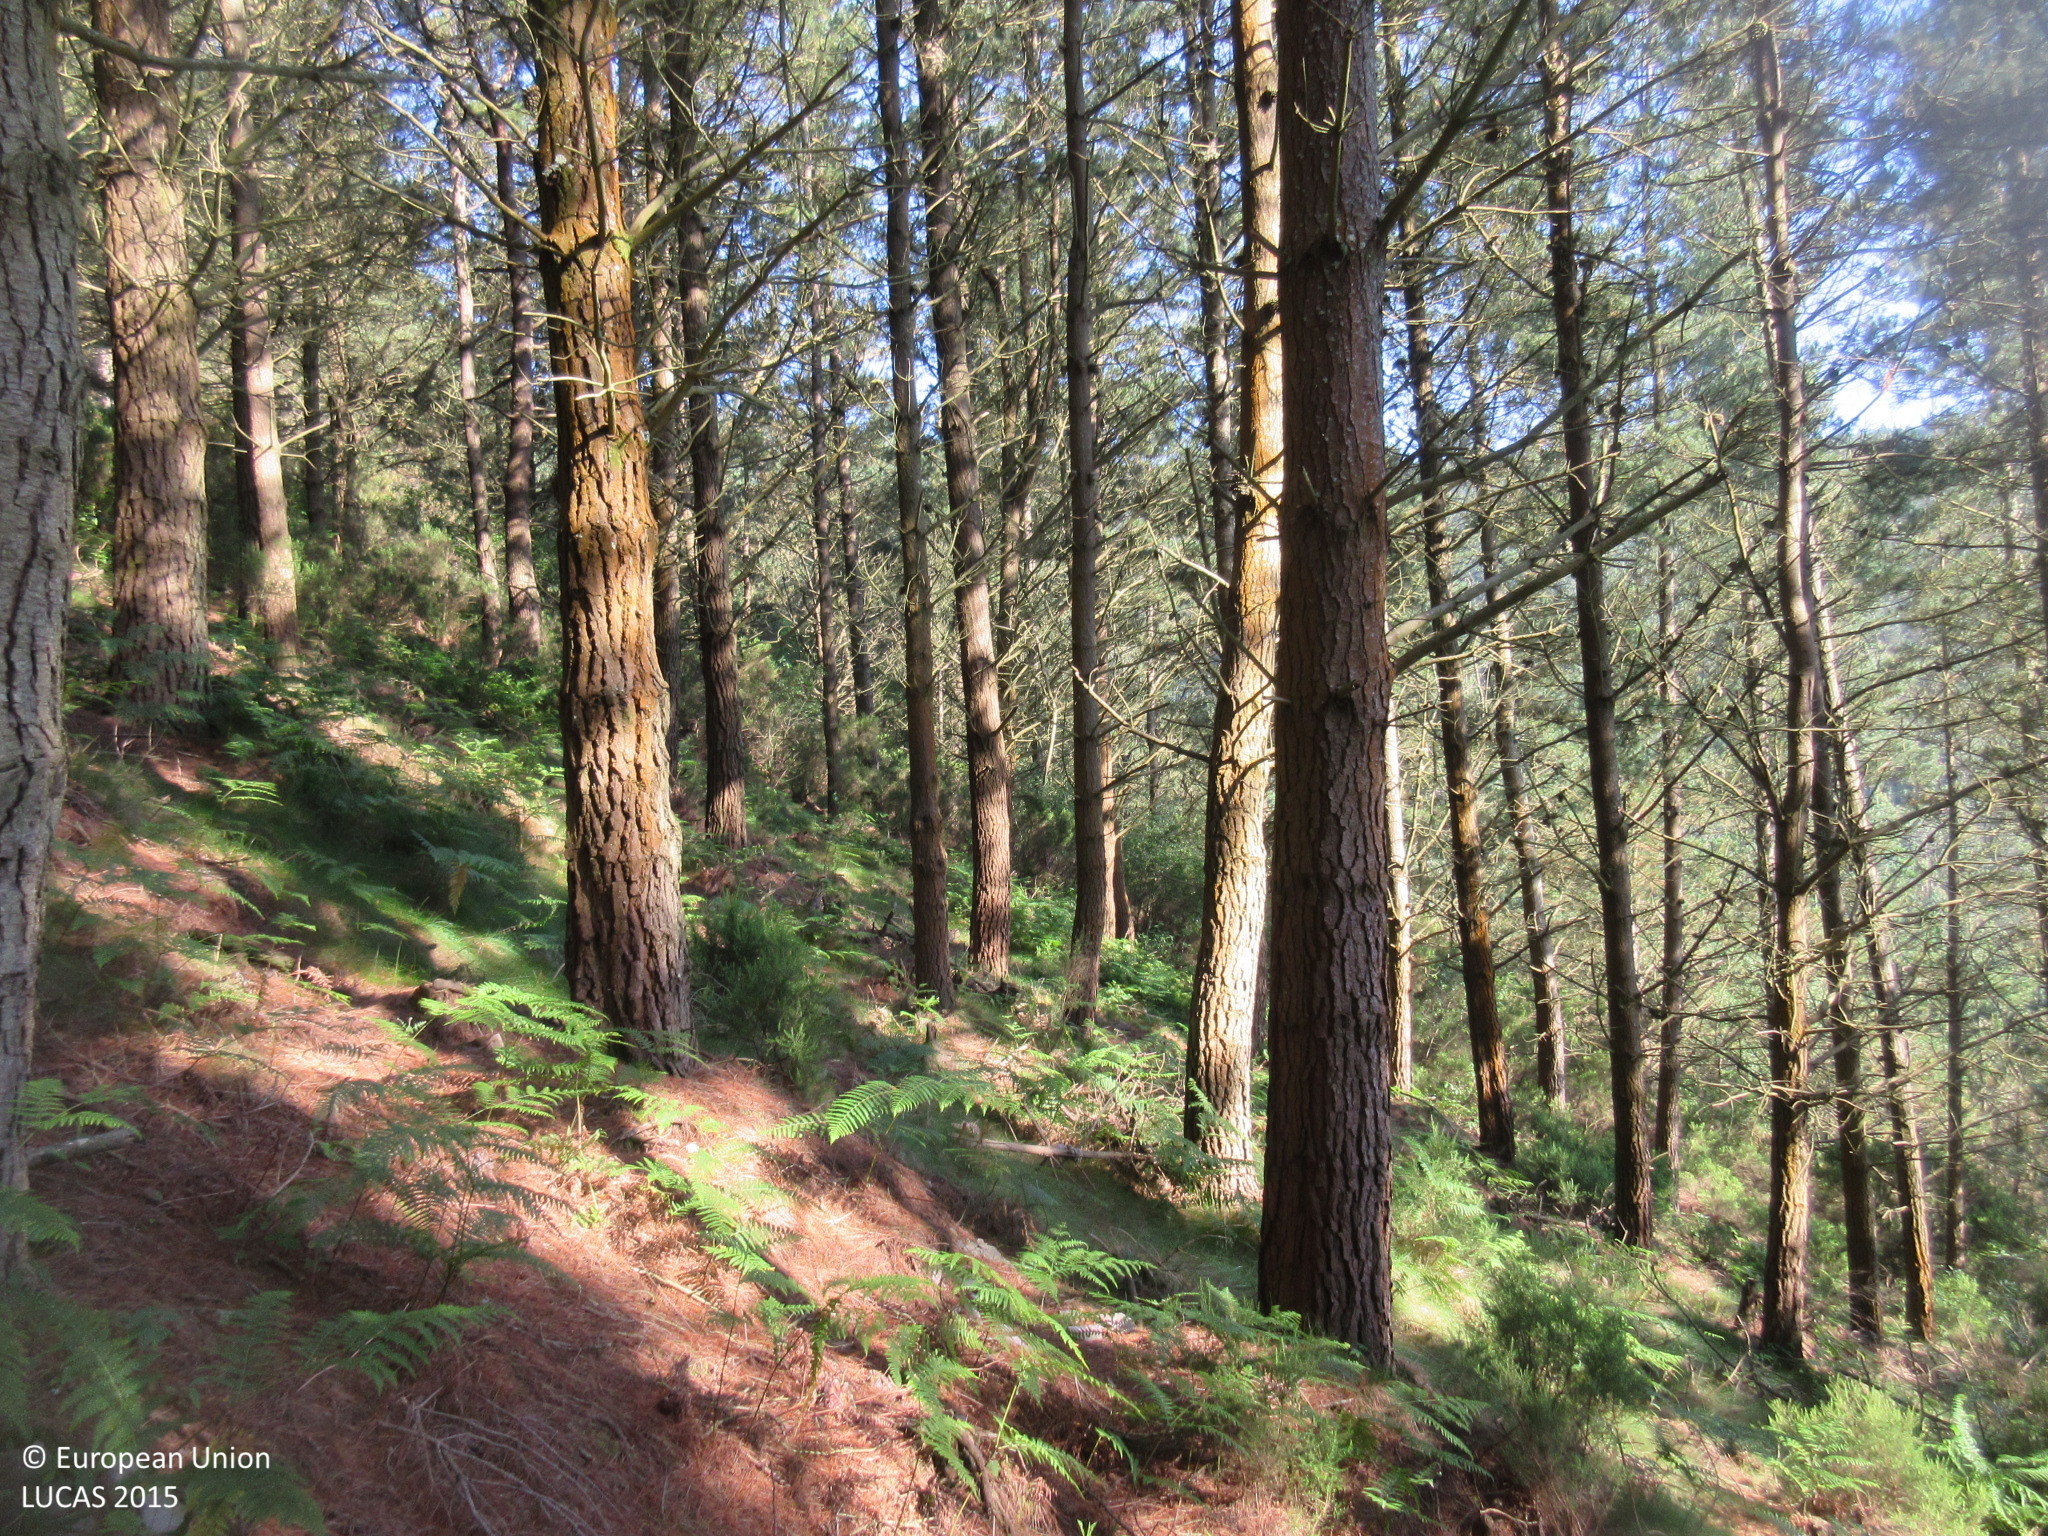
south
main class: Woodland
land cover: Pine dominated coniferous woodland
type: hemiboreal forest and nemoral coniferous forest and mixed broadleaved-coniferous forest
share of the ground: > 75 %
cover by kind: coniferous forest trees 95 %, shrubs 5 %
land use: Forestry
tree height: > 5 m
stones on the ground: > 50 %
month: June
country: ES
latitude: 43.4058
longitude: -7.0470
